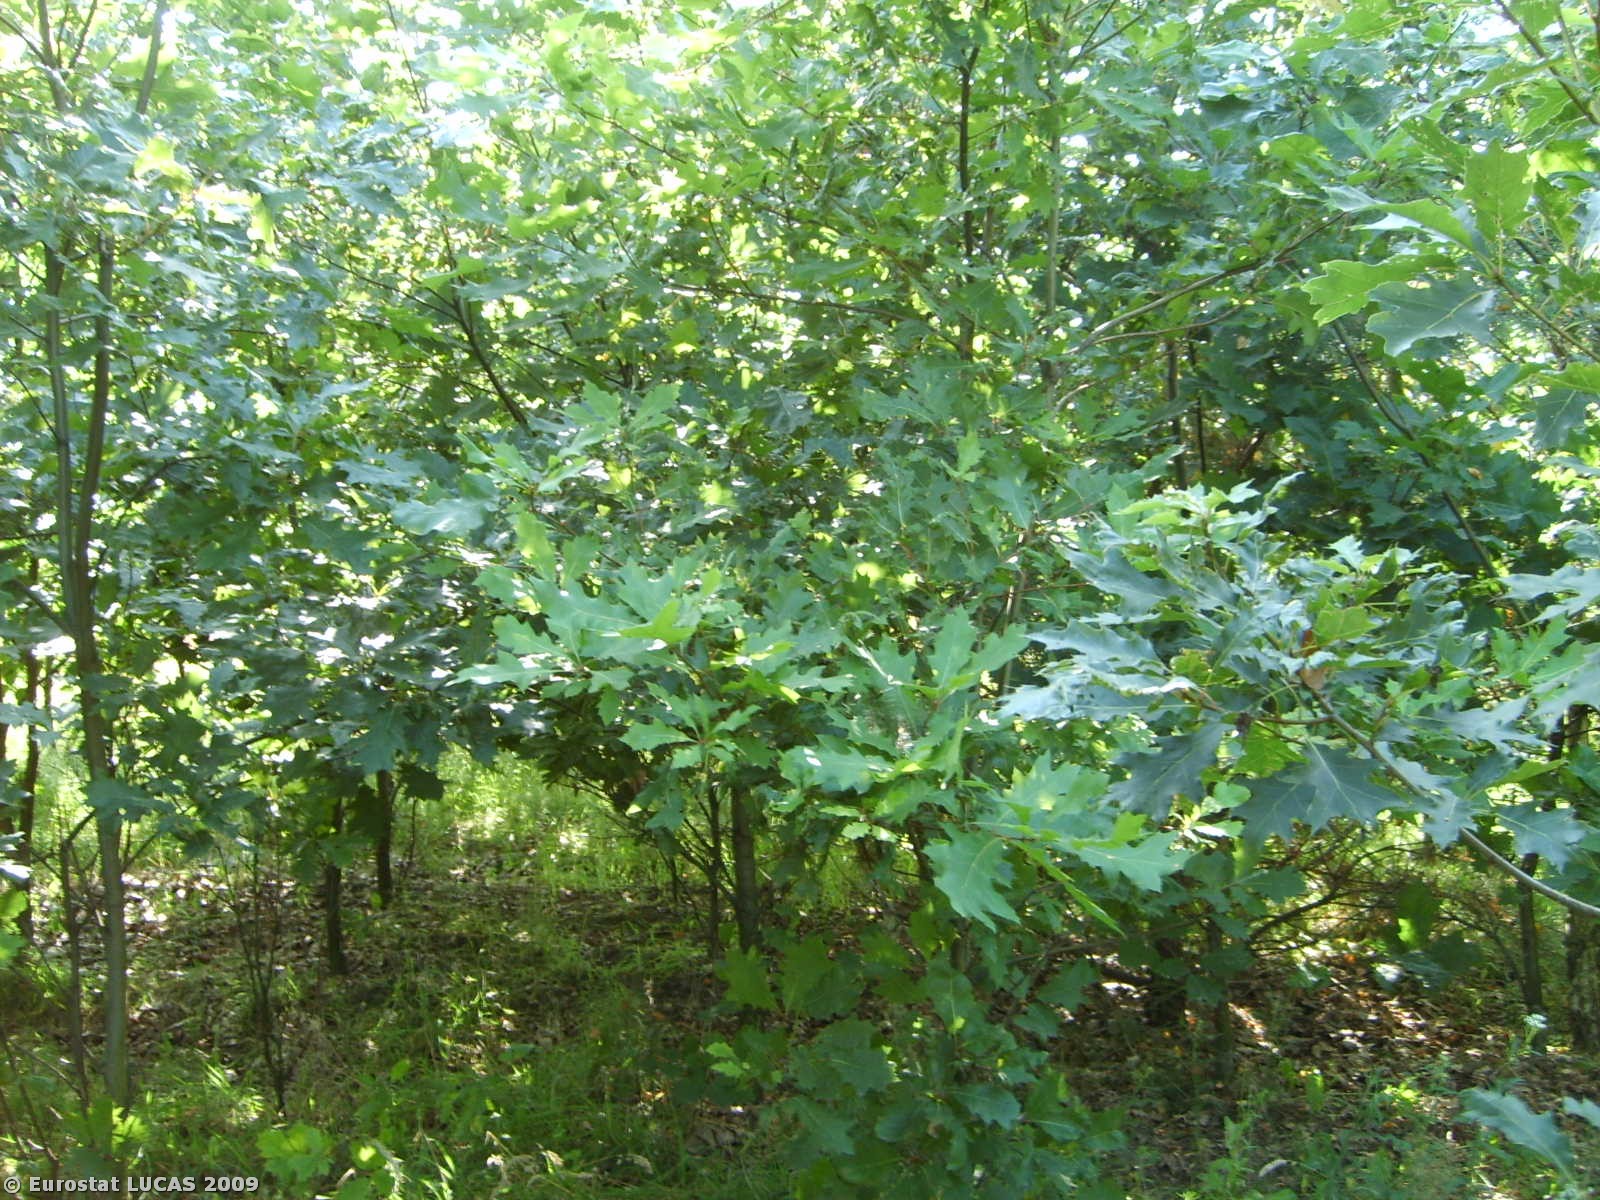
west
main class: Woodland
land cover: Broadleaved woodland
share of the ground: > 75 %
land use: Forestry
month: July
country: PL
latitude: 51.5937
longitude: 22.0843
